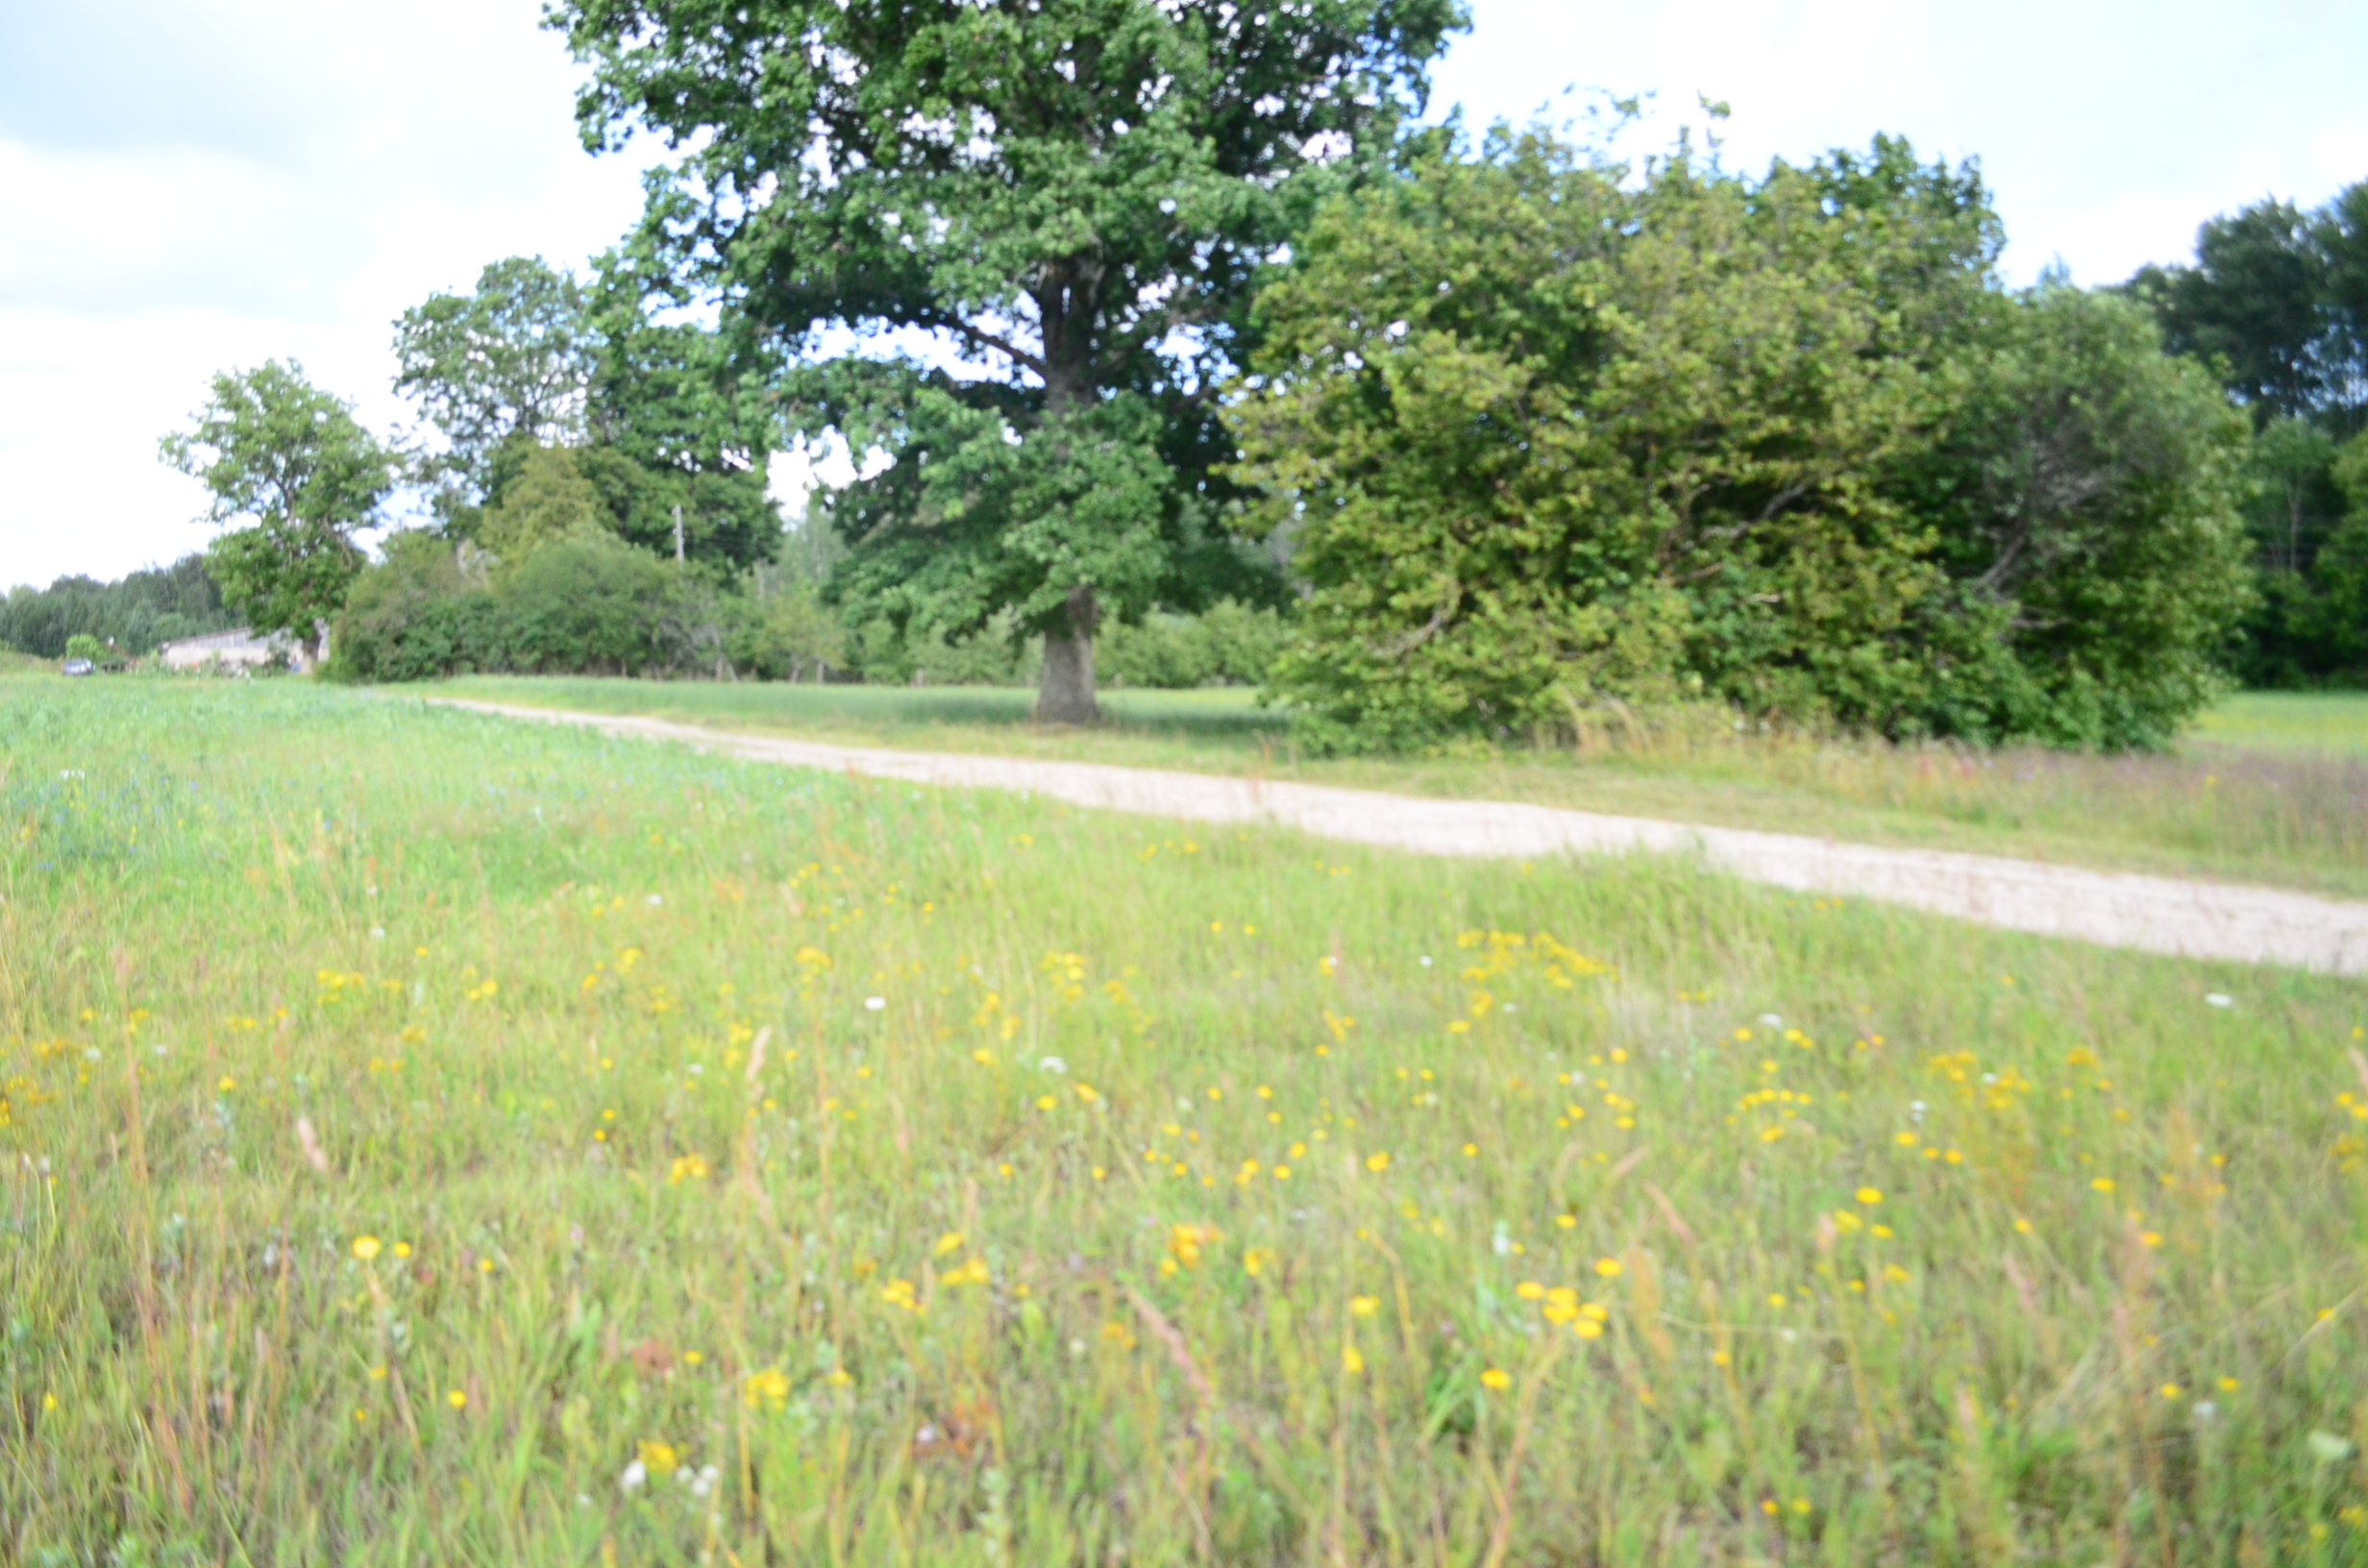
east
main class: Grassland
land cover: Grassland without tree/shrub cover
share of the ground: > 75 %
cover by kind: herbaceous plants 100 %
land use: Agriculture (excluding fallow land and kitchen gardens)
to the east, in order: Grassland without tree/shrub cover; Dry pulses; Grass margins; Paved roads, cycling and walking lanes; Common wheat; Artificial constructions in urban areas; Potatoes; Shruby margins; Barley; Broadleaved woodland
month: July
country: LV
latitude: 57.0703
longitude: 22.4742
